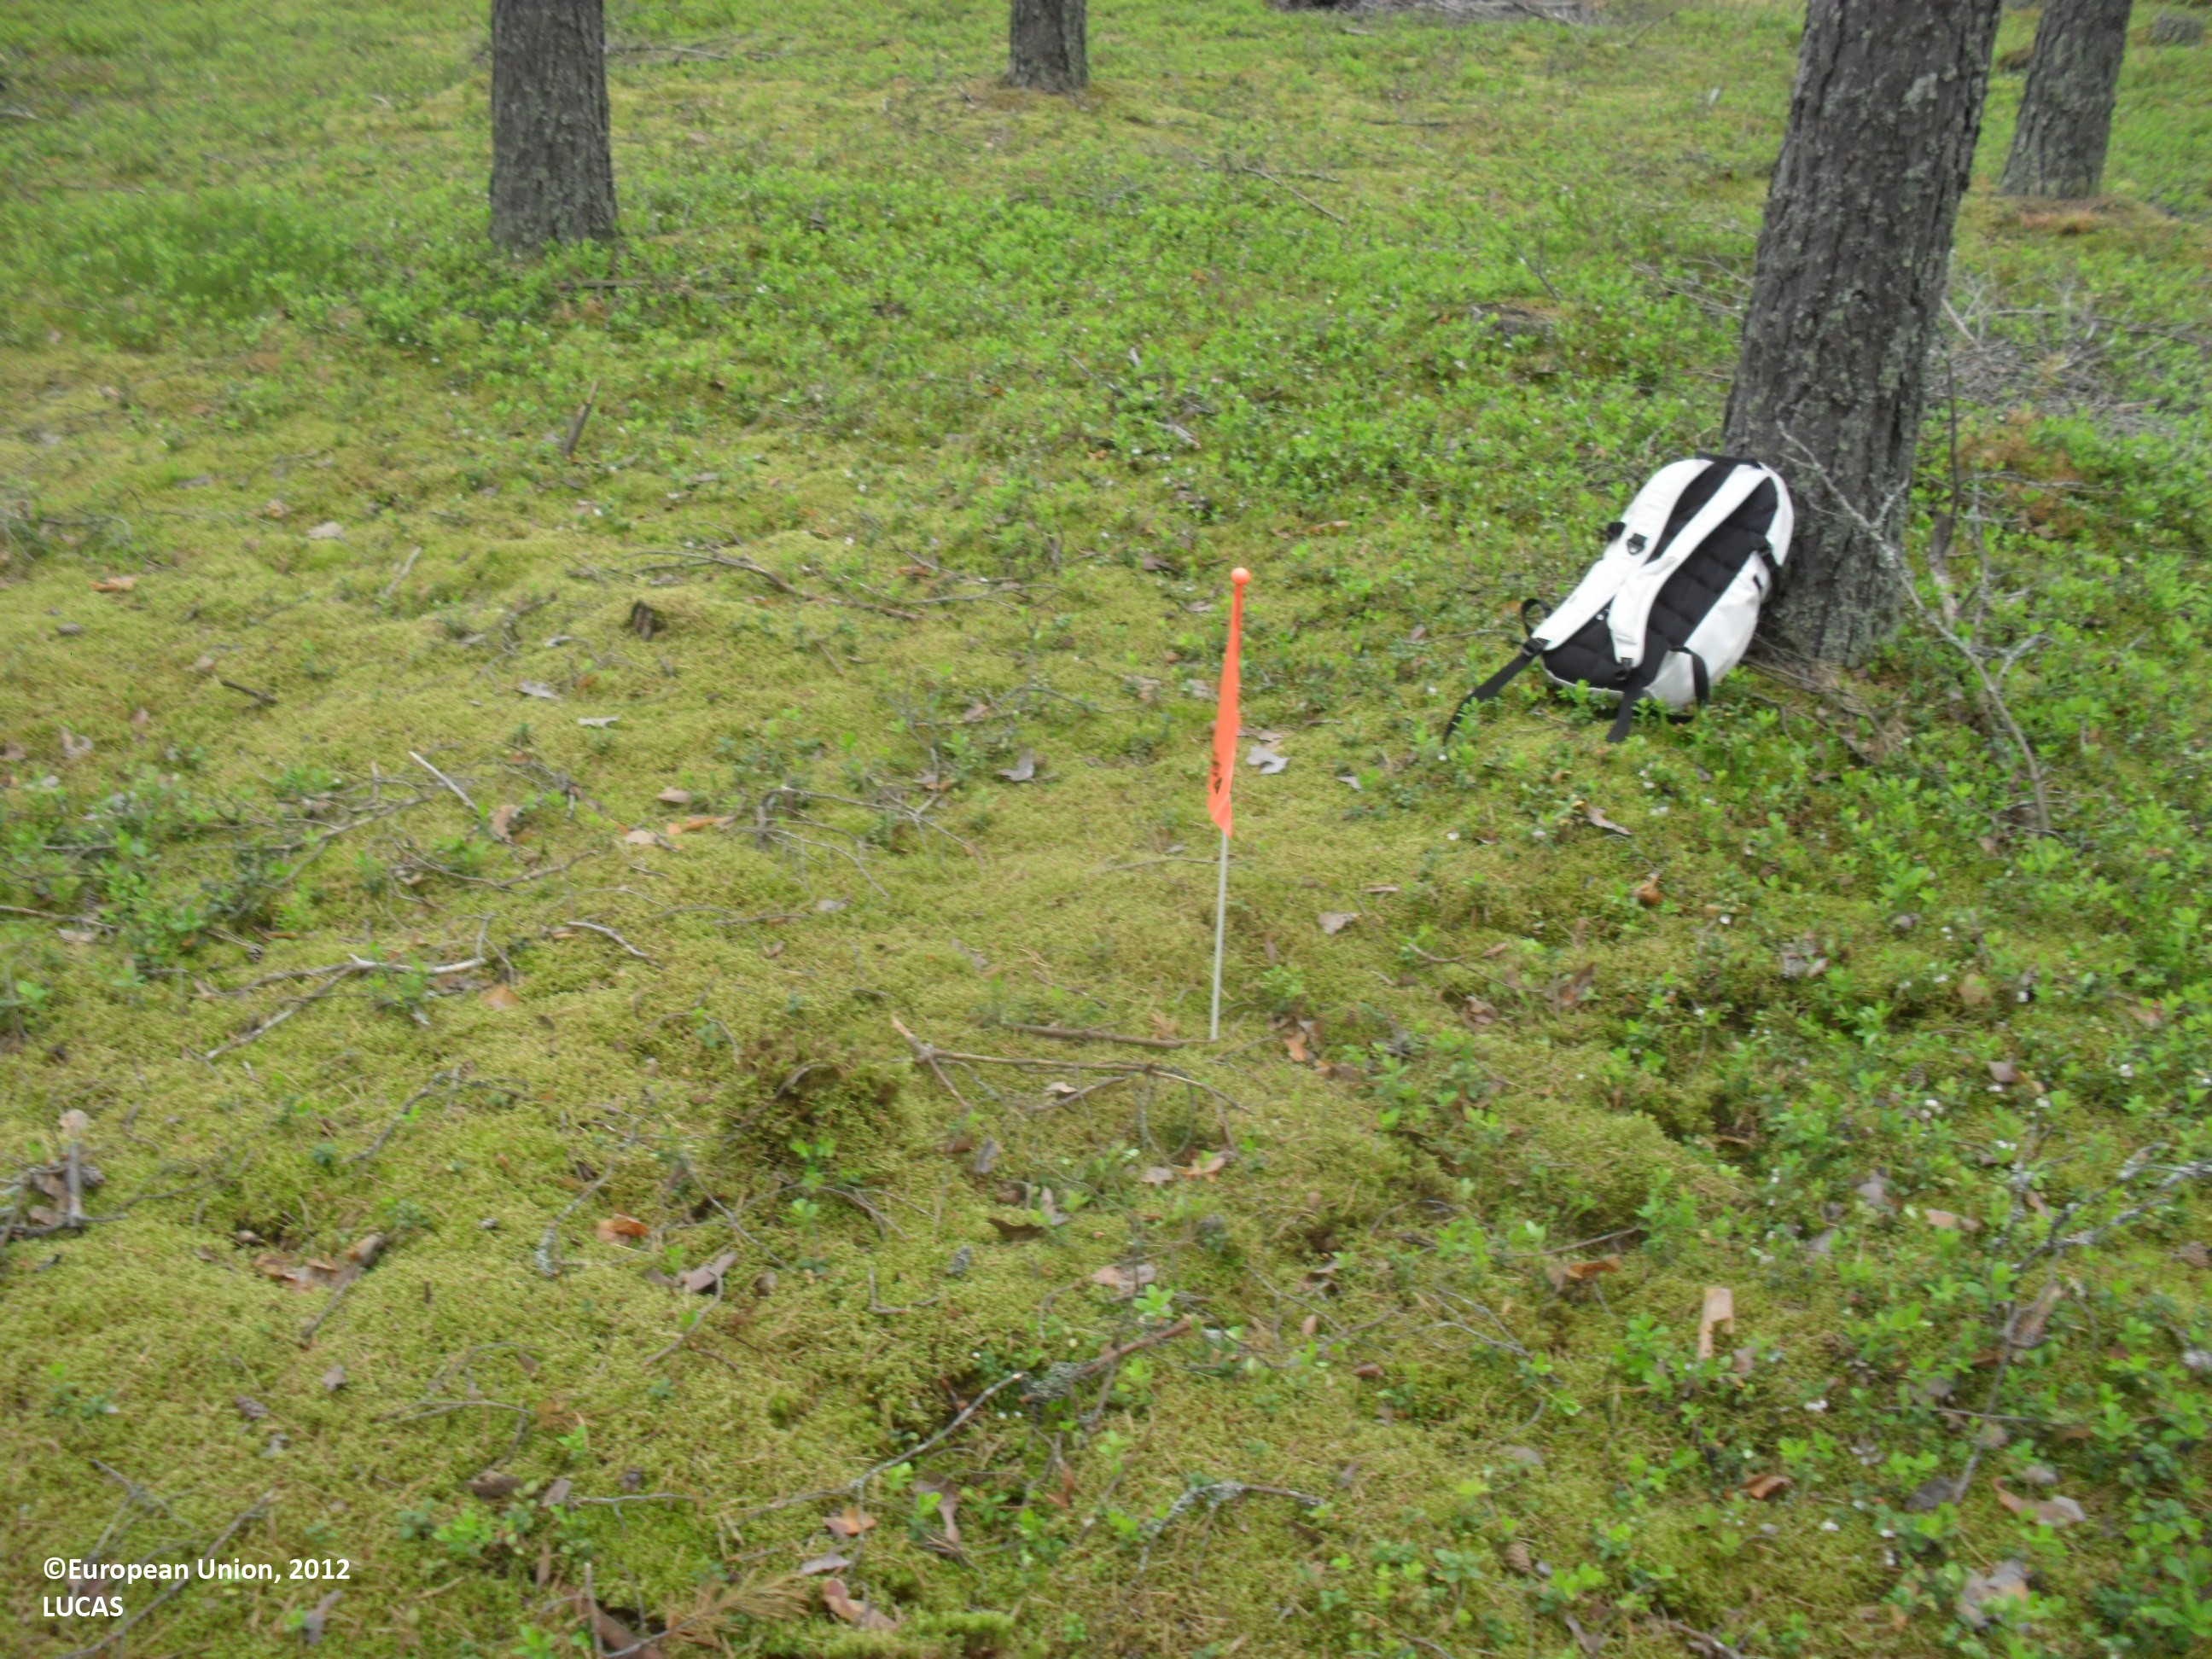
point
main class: Woodland
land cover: Pine dominated coniferous woodland
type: boreal forest
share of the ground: 25 - 50 %
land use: Forestry
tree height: > 5 m
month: June
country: FI
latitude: 62.9521
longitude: 23.5305
